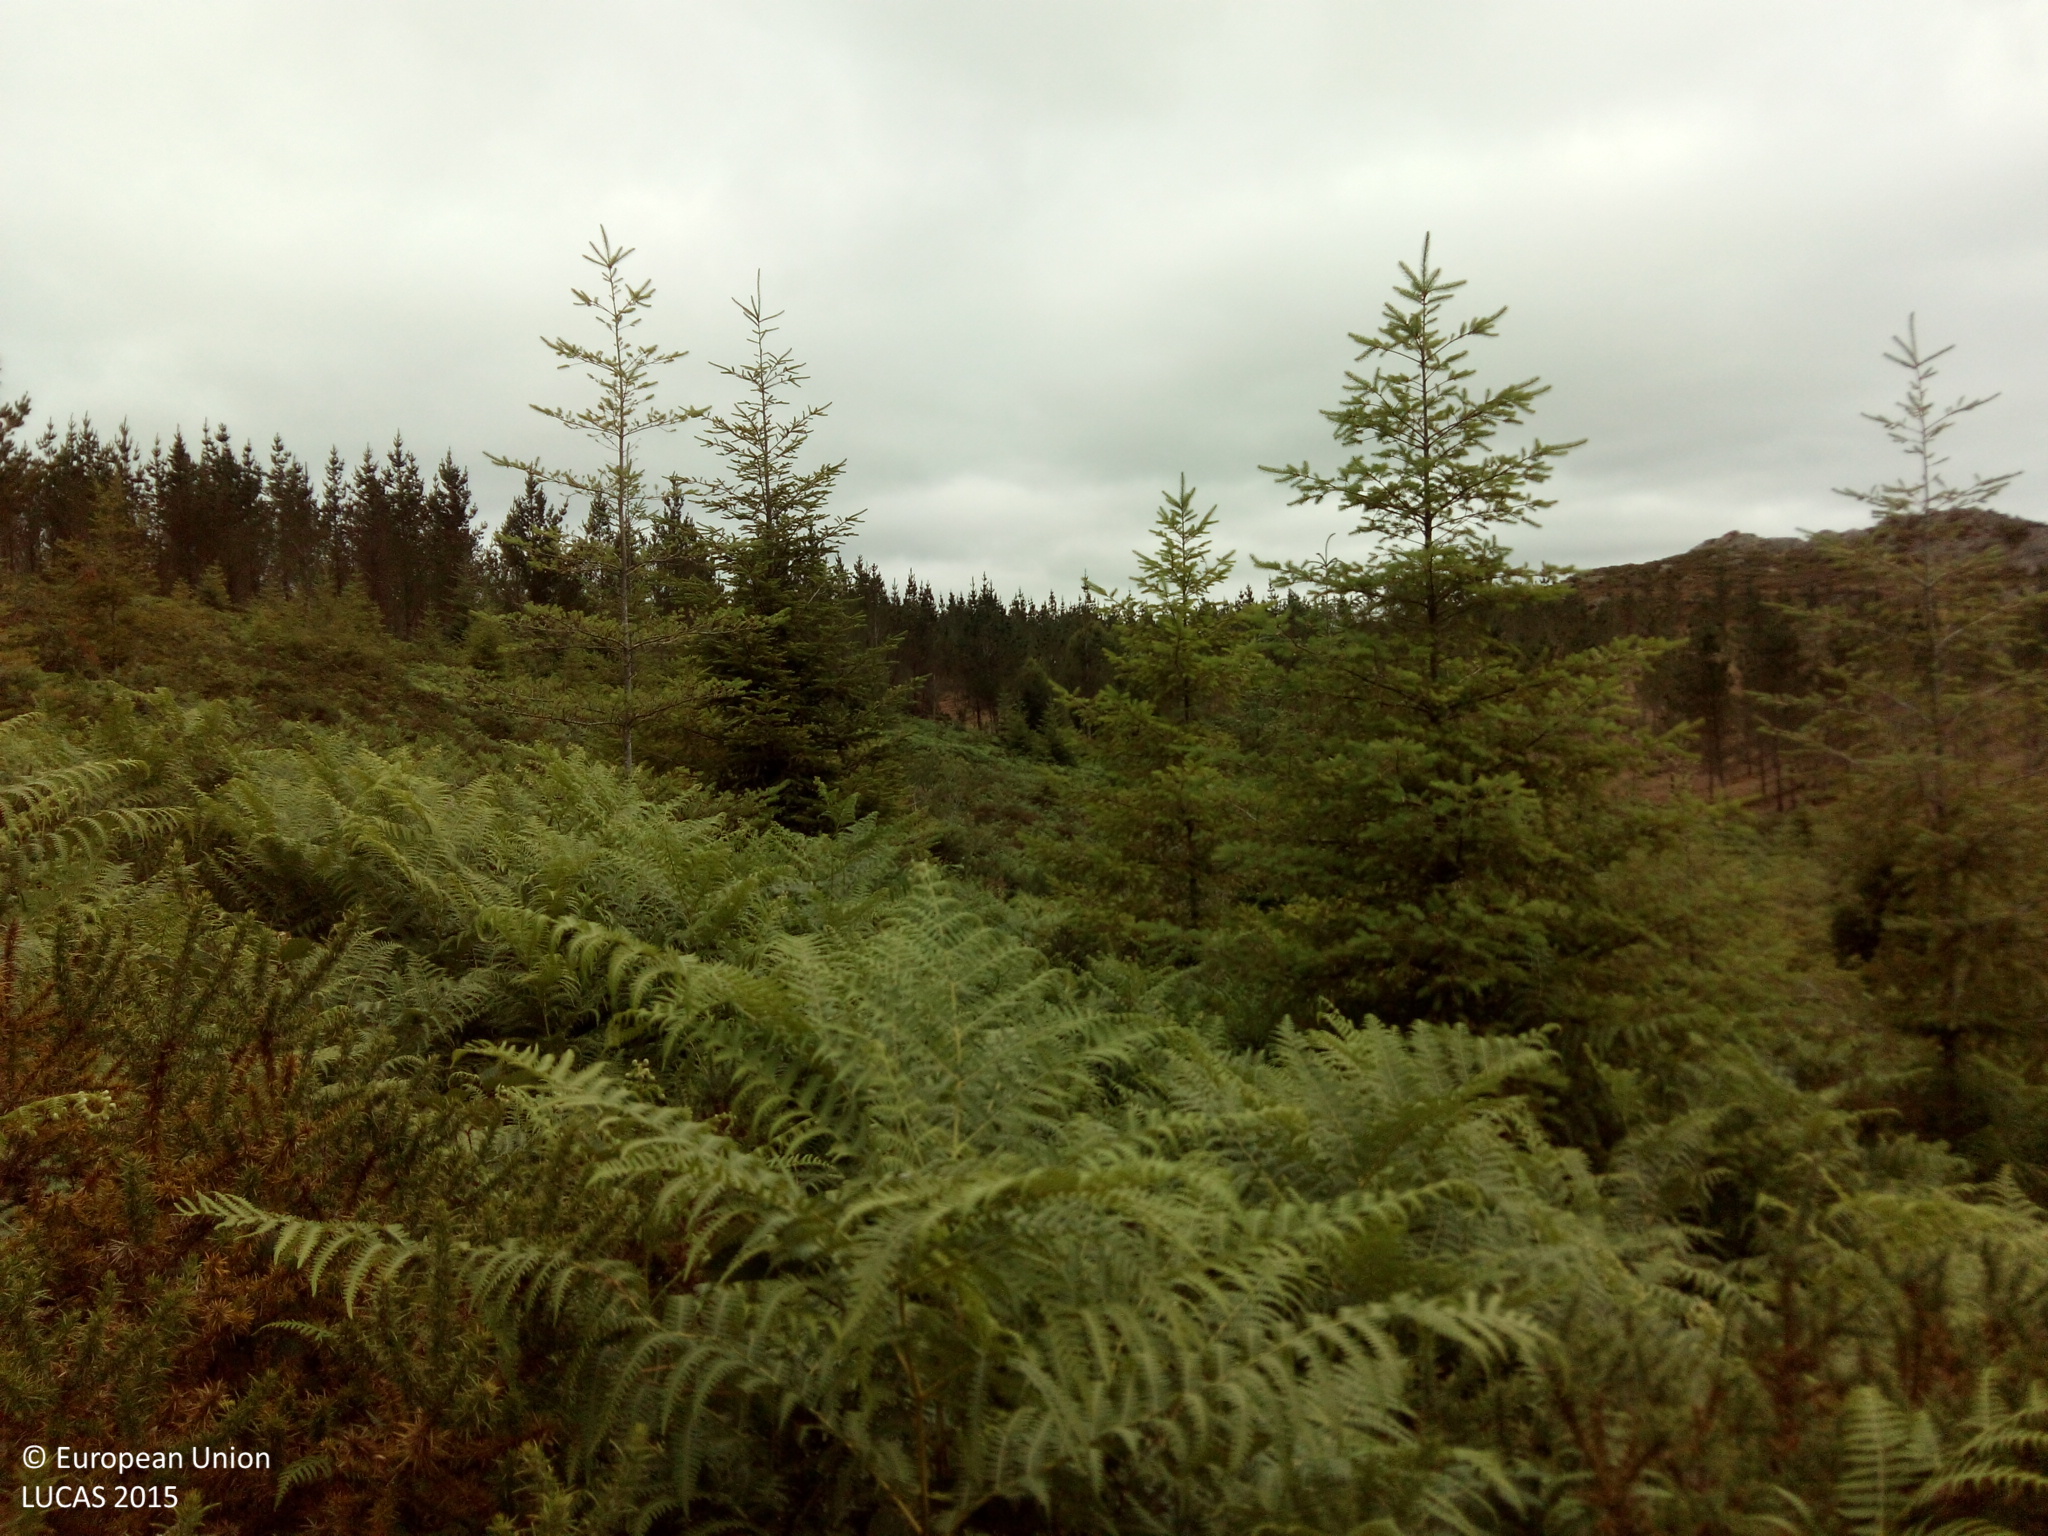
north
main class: Woodland
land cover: Spruce dominated coniferous woodland
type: exotic forest
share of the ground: > 75 %
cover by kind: shrubs 70 %, coniferous forest trees 30 %
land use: Forestry
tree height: < 5 m
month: July
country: ES
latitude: 42.5797
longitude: -8.3839
